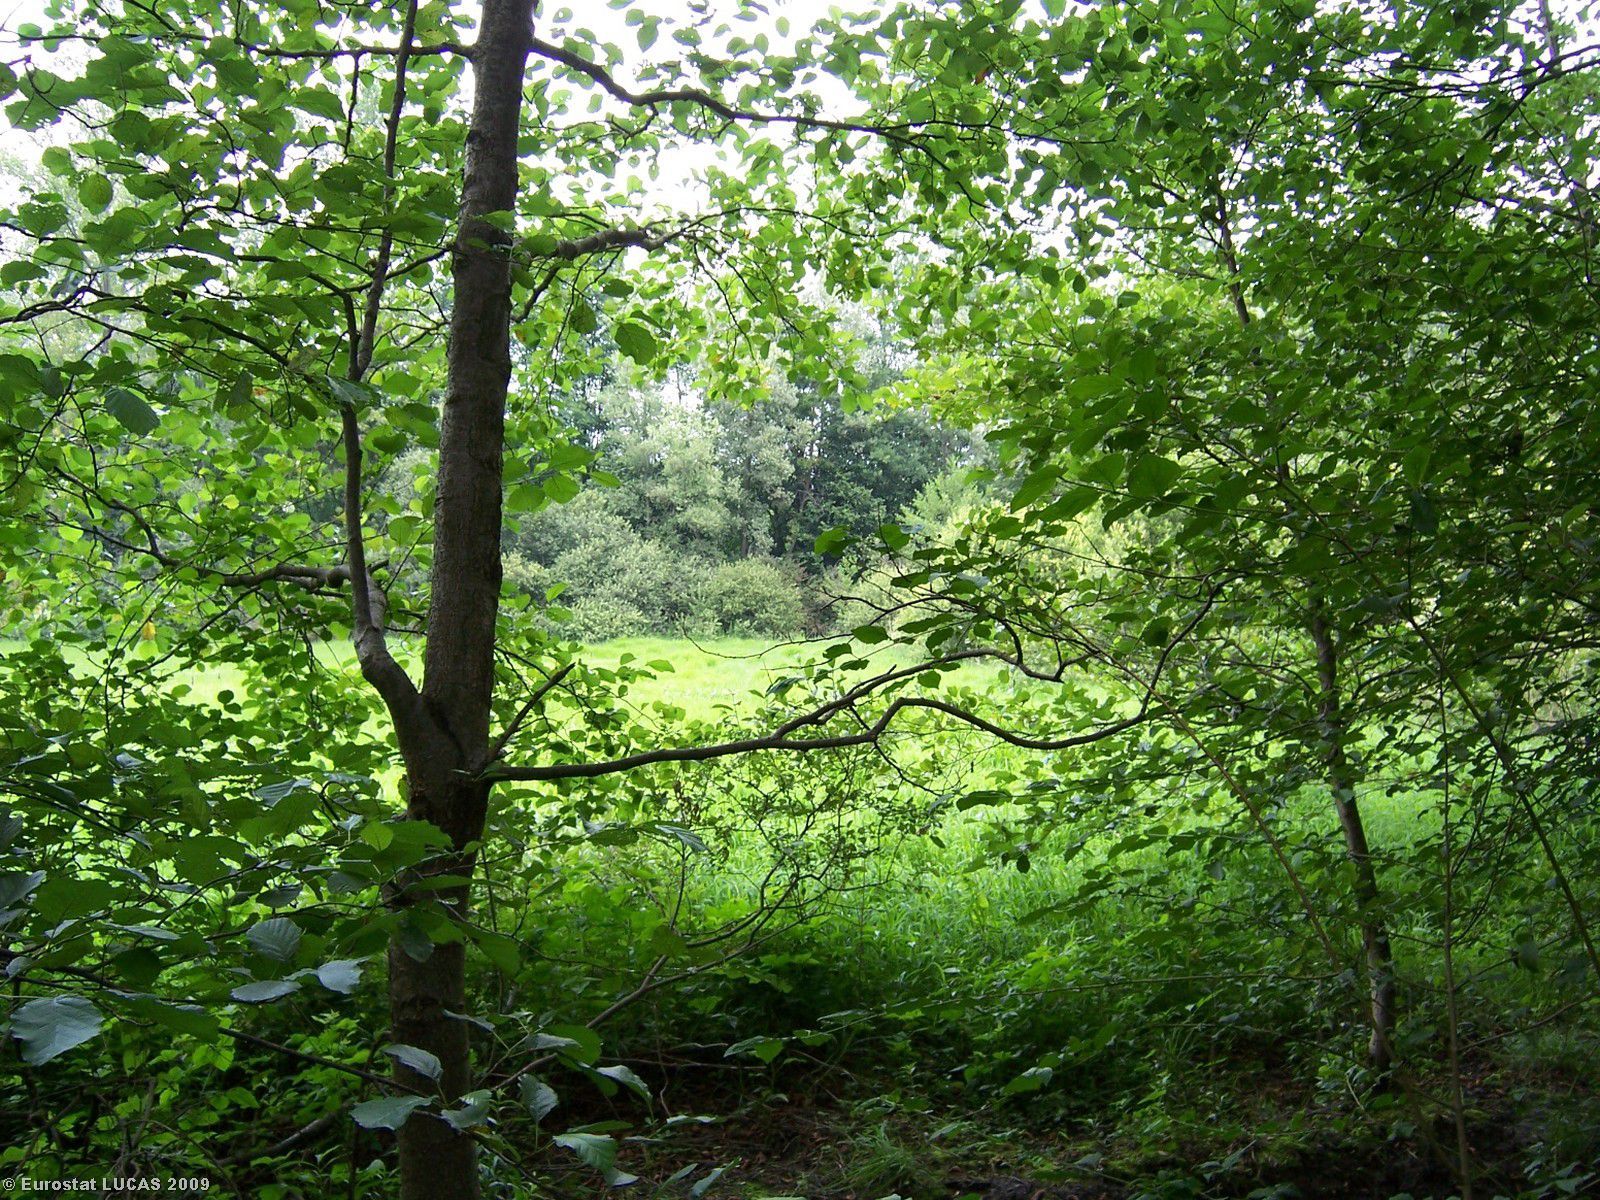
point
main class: Woodland
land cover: Broadleaved woodland
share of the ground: > 75 %
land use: Nature reserves
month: July
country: IT
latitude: 45.0751
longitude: 7.3751
